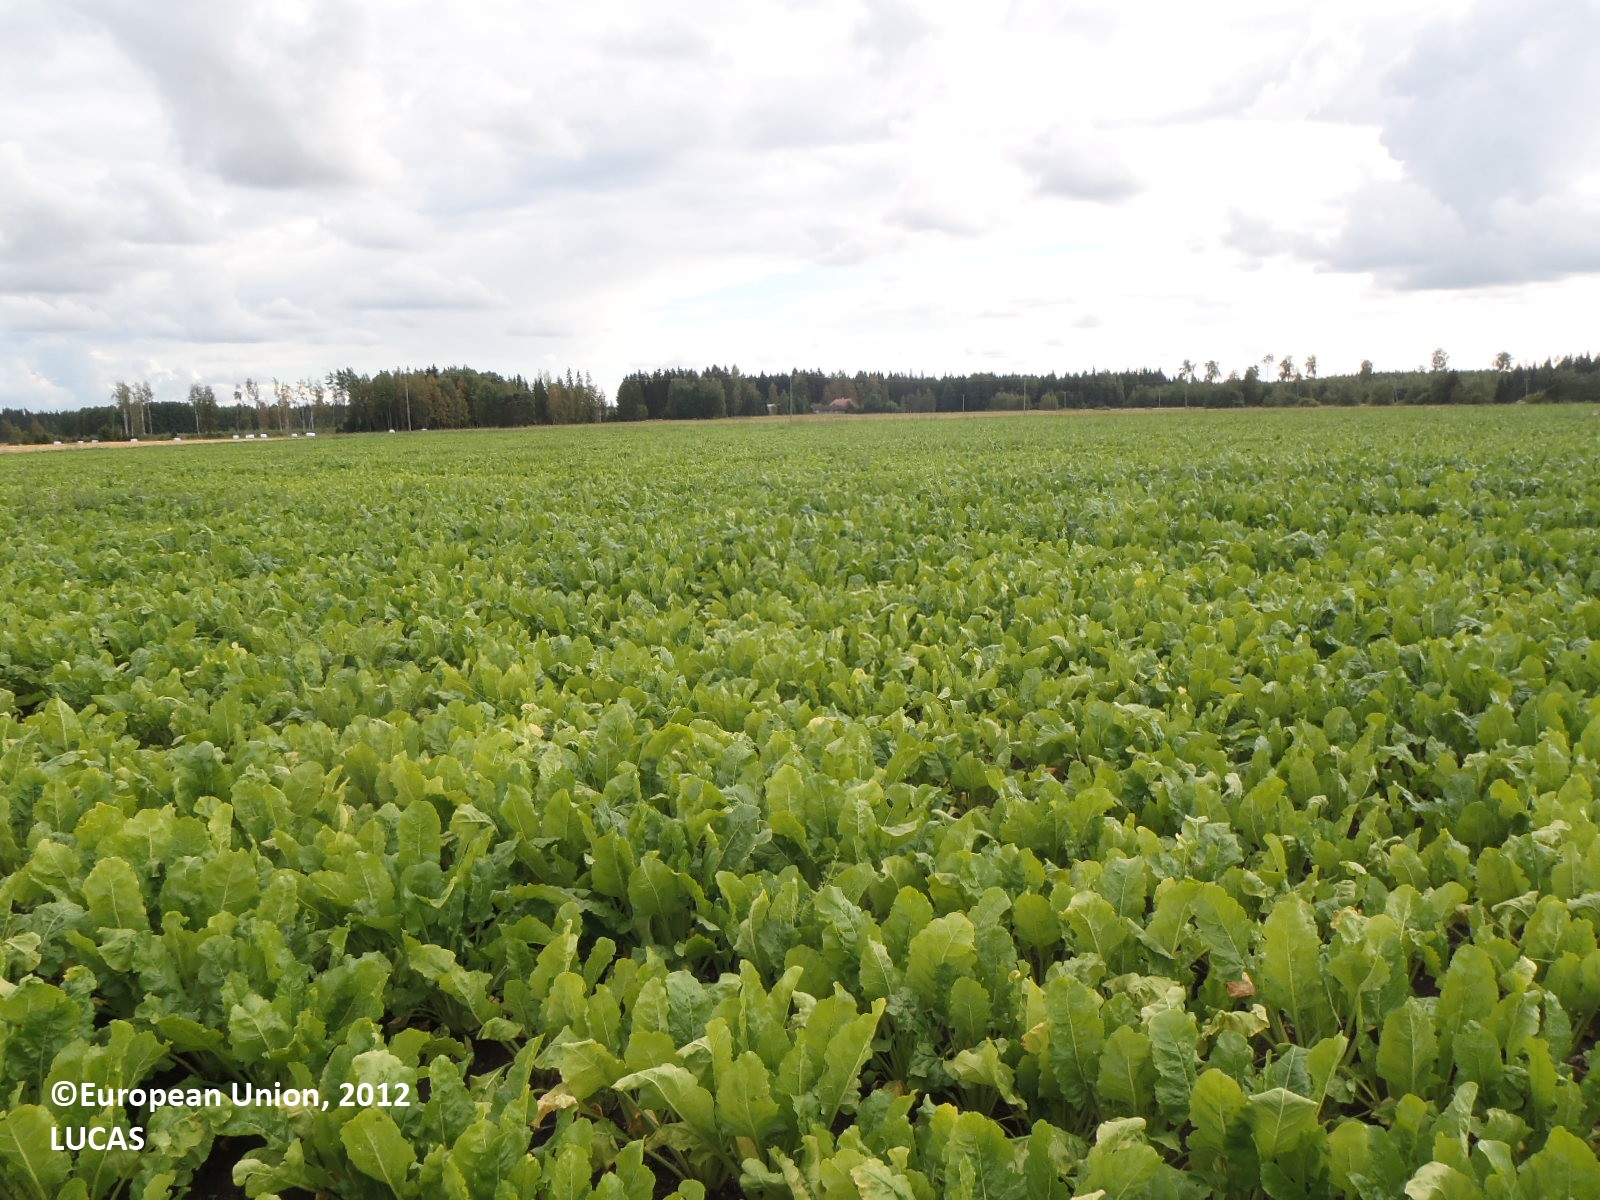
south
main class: Cropland
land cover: Sugar beet
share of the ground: > 75 %
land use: Agriculture (excluding fallow land and kitchen gardens)
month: August
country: FI
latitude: 60.6553
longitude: 22.3787
